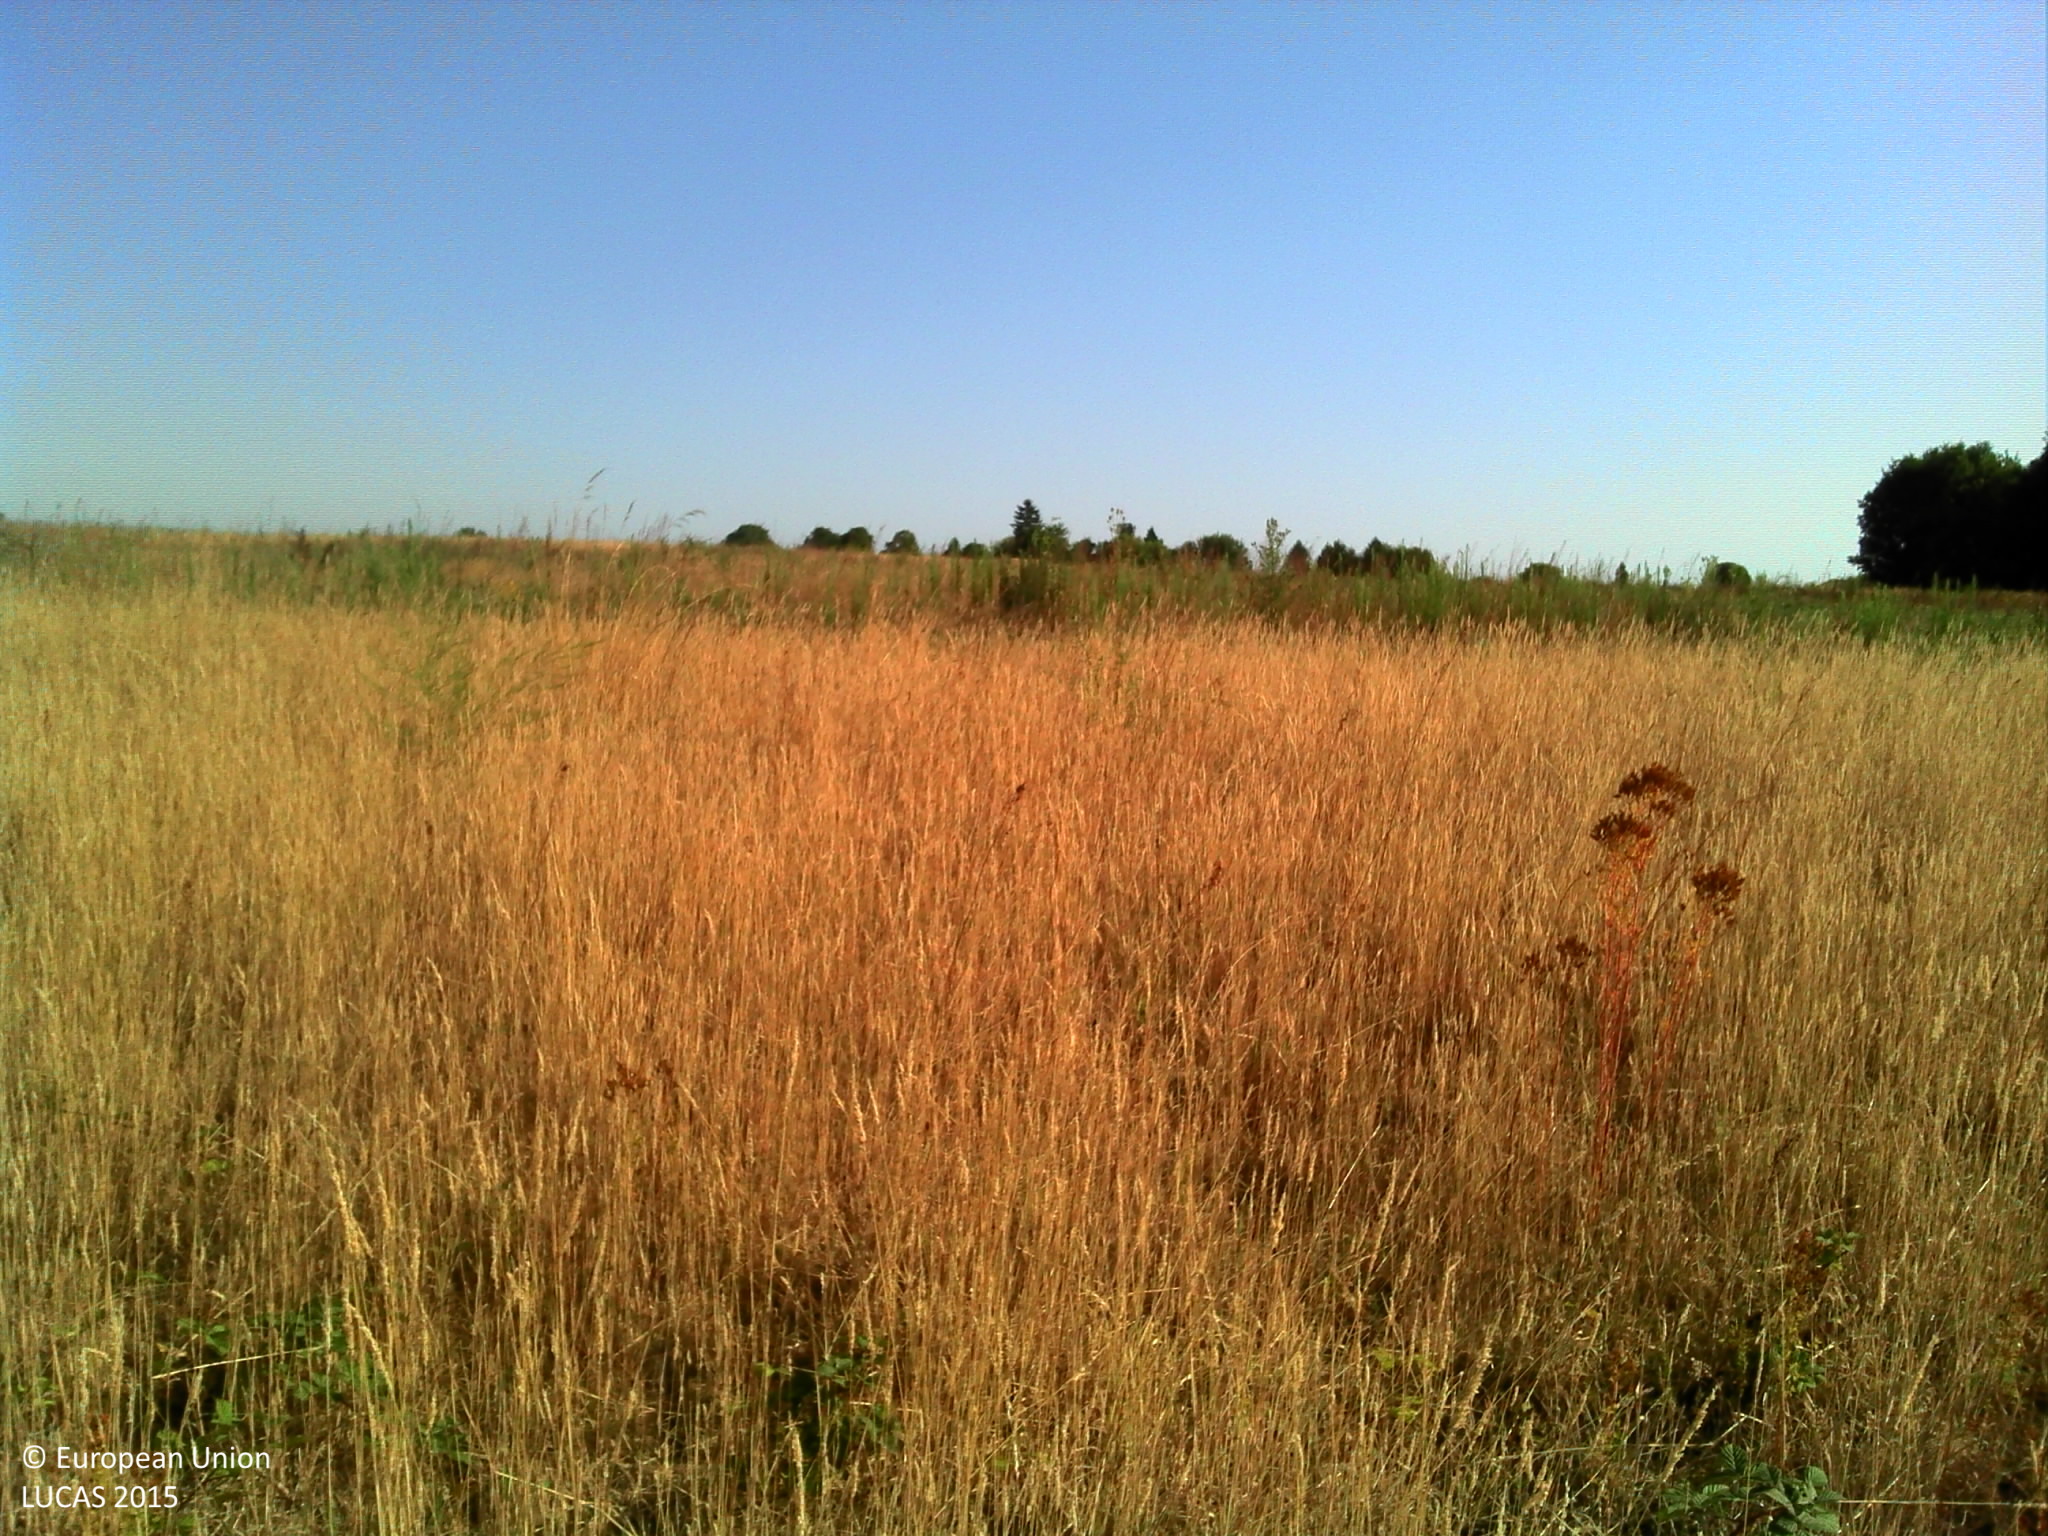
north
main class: Grassland
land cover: Grassland without tree/shrub cover
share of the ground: > 75 %
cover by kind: herbaceous plants 100 %
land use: Agriculture (excluding fallow land and kitchen gardens)
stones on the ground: 10 - 25 %
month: July
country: FR
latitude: 47.0739
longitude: 2.1293
